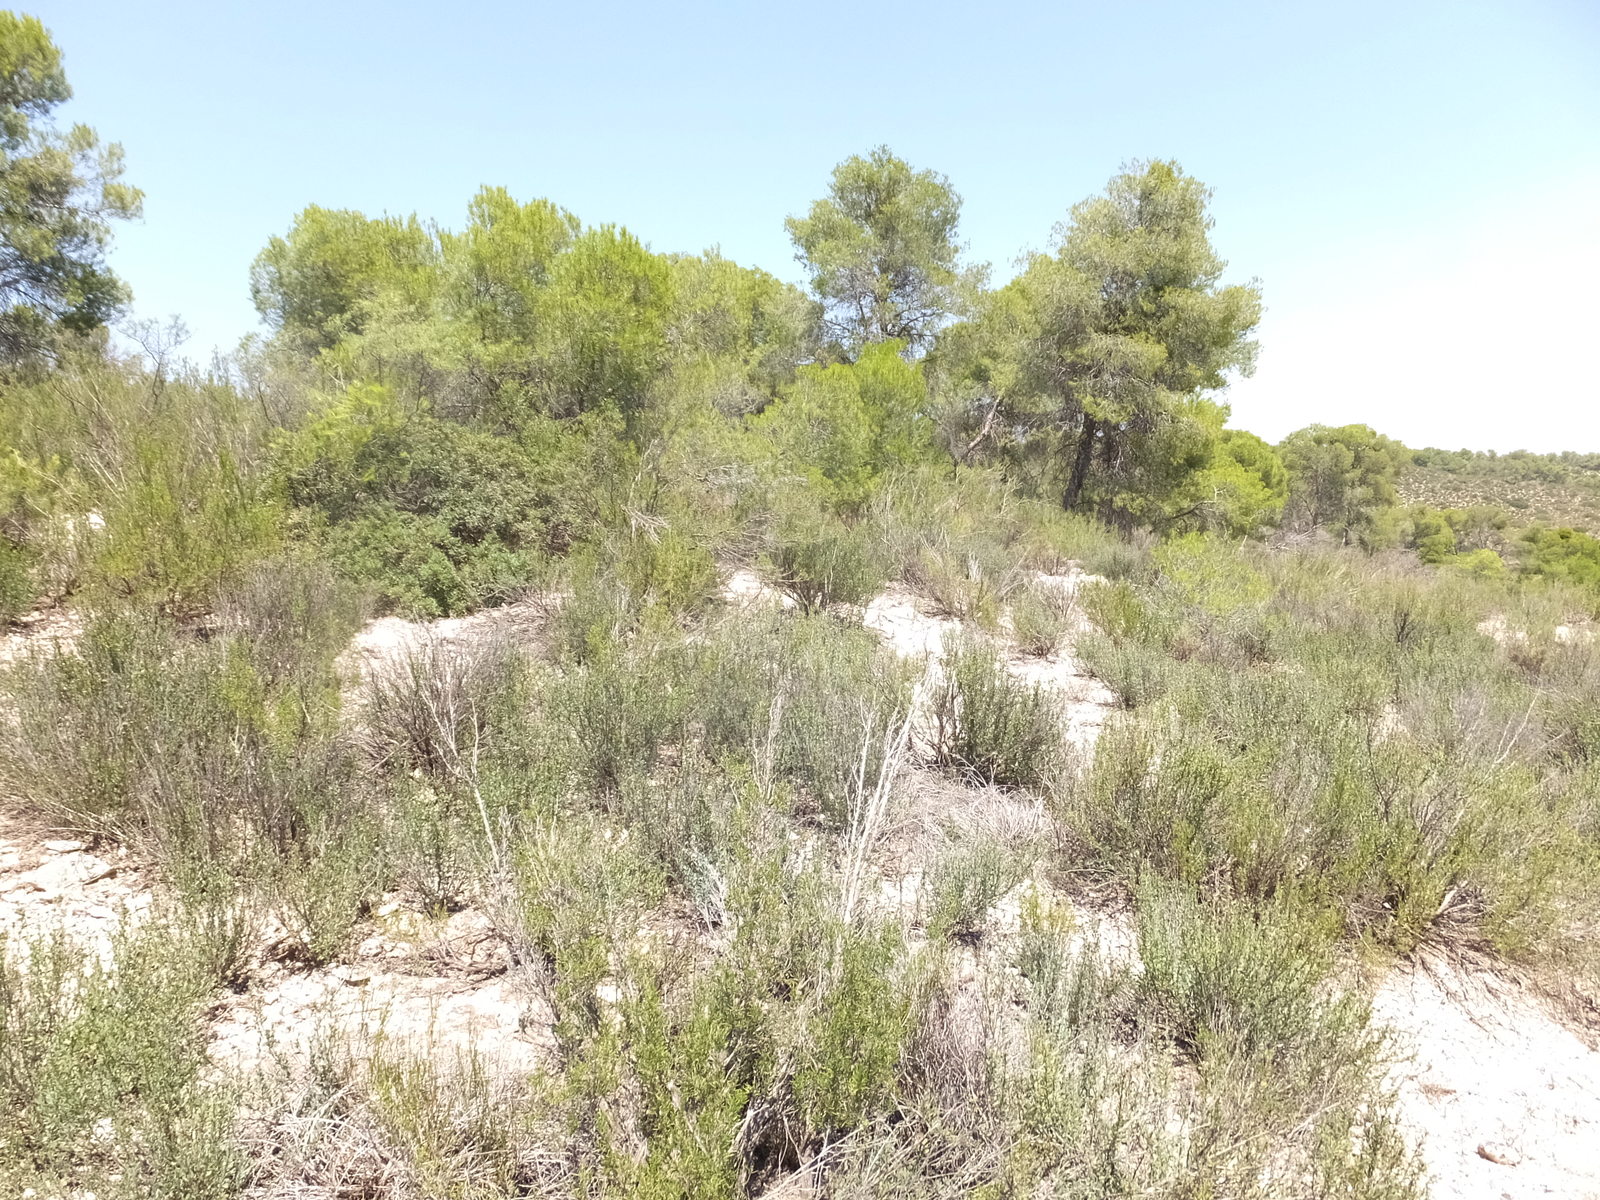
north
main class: Shrubland
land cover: Shrubland with sparse tree cover
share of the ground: > 75 %
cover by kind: shrubs 60 %, herbaceous plants 35 %, coniferous forest trees 5 %
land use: Semi-natural and natural areas not in use
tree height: < 5 m
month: August
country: ES
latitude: 41.4010
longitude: 0.0708
